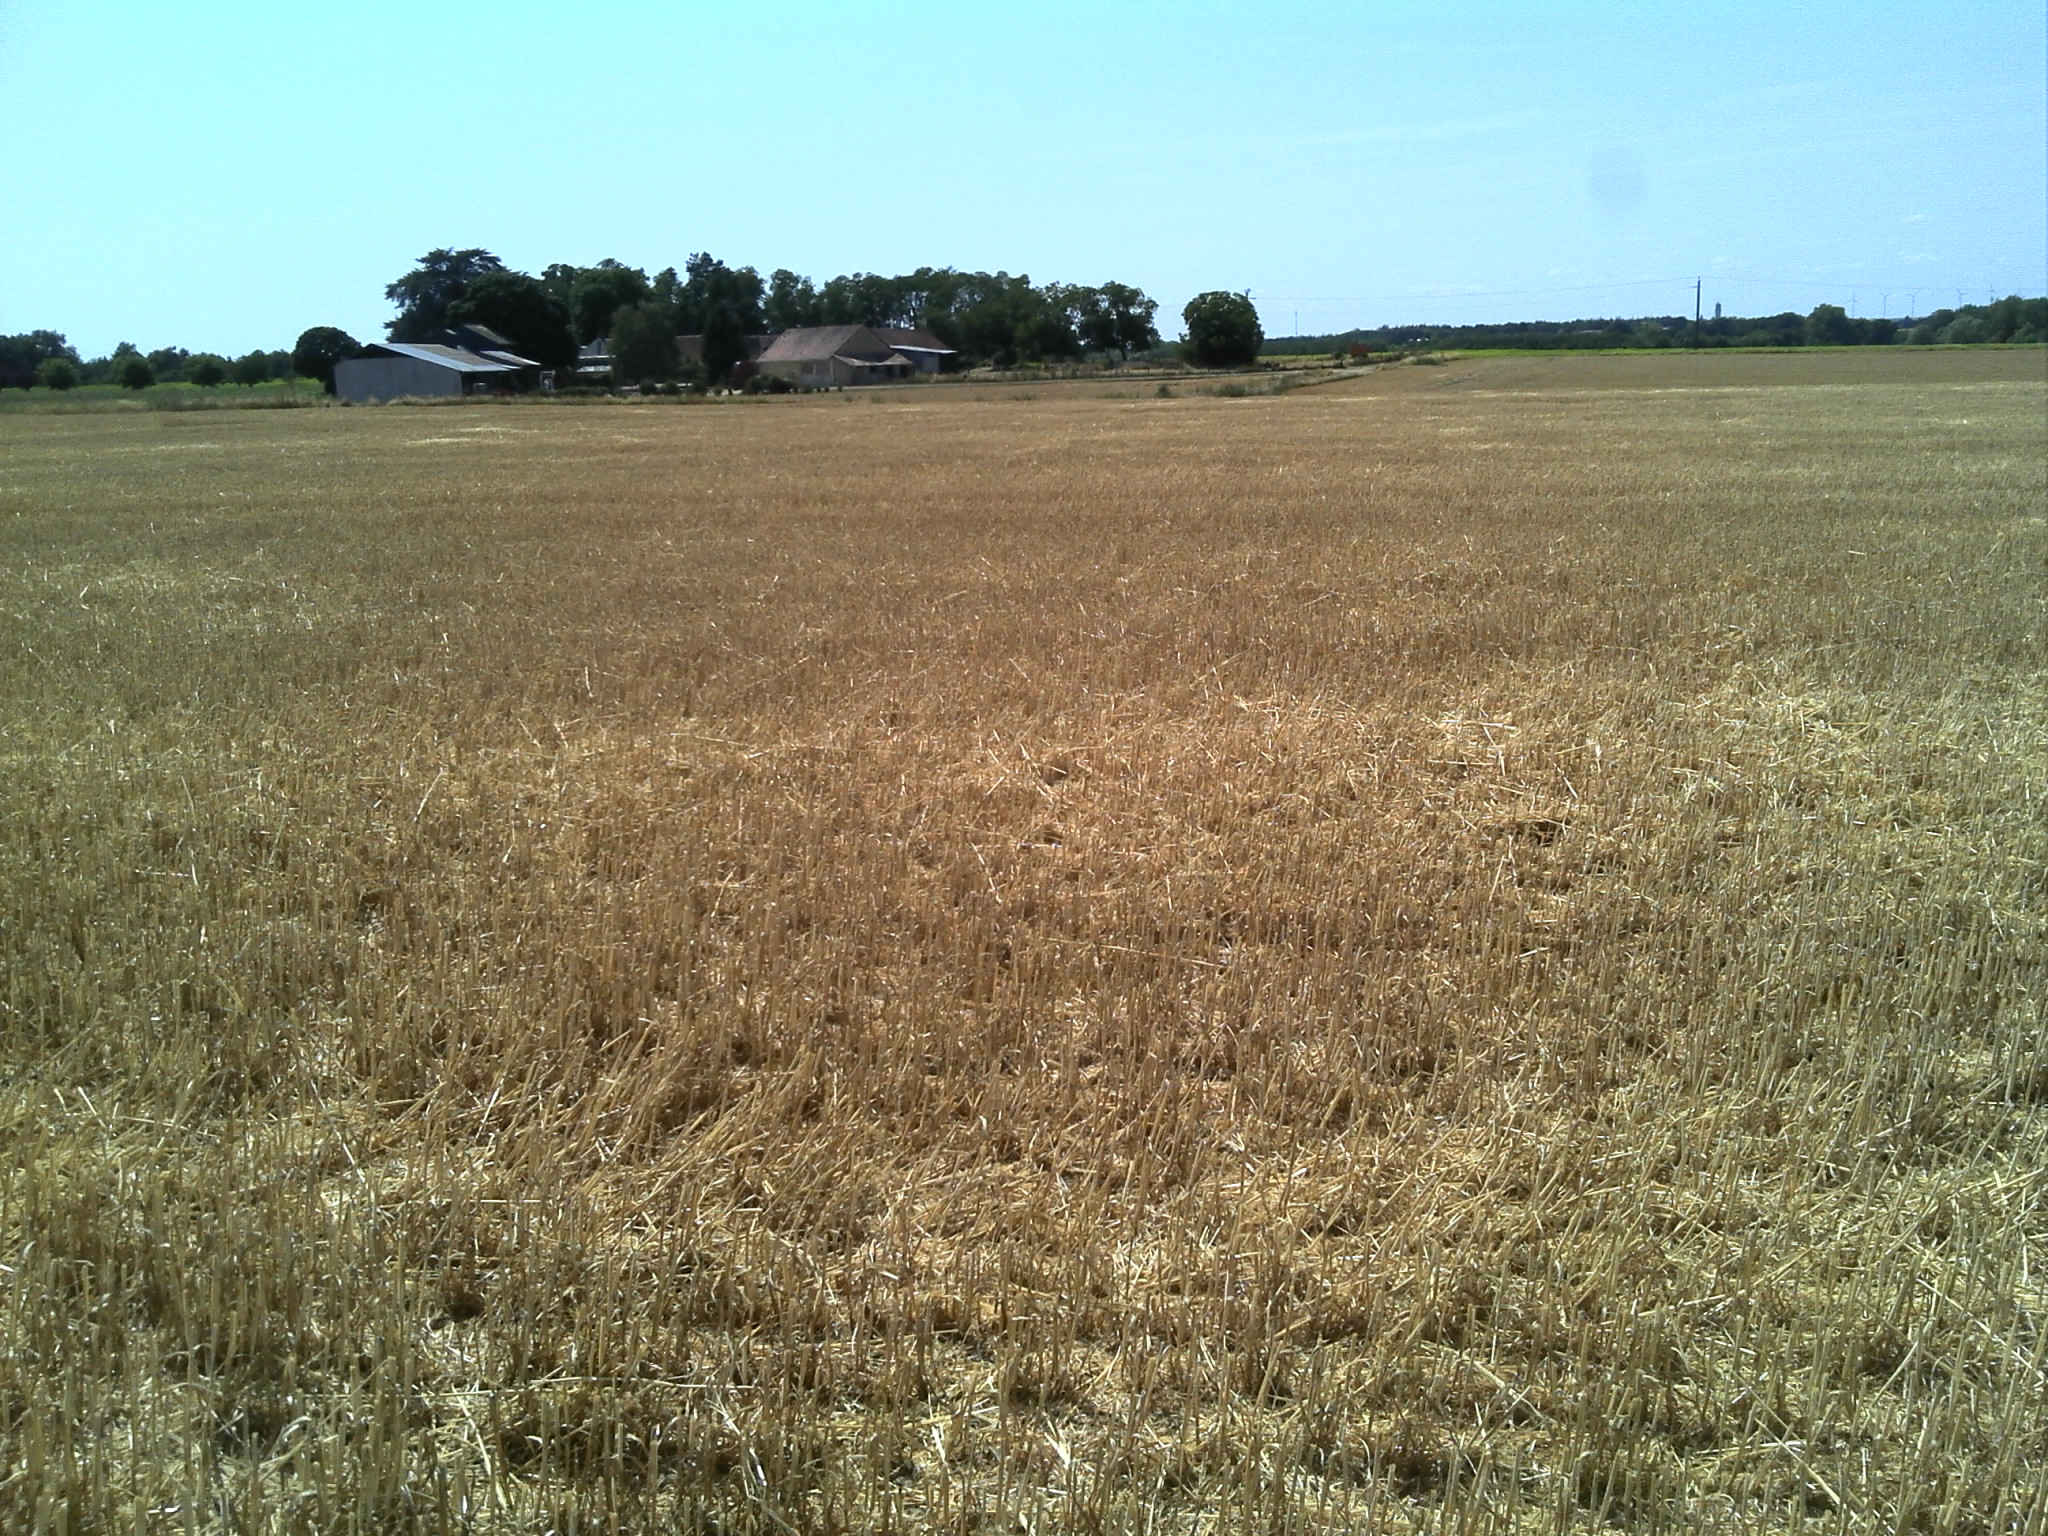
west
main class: Cropland
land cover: Durum wheat
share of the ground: 50 - 75 %
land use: Agriculture (excluding fallow land and kitchen gardens)
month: July
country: FR
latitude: 46.8792
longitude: 1.4722
